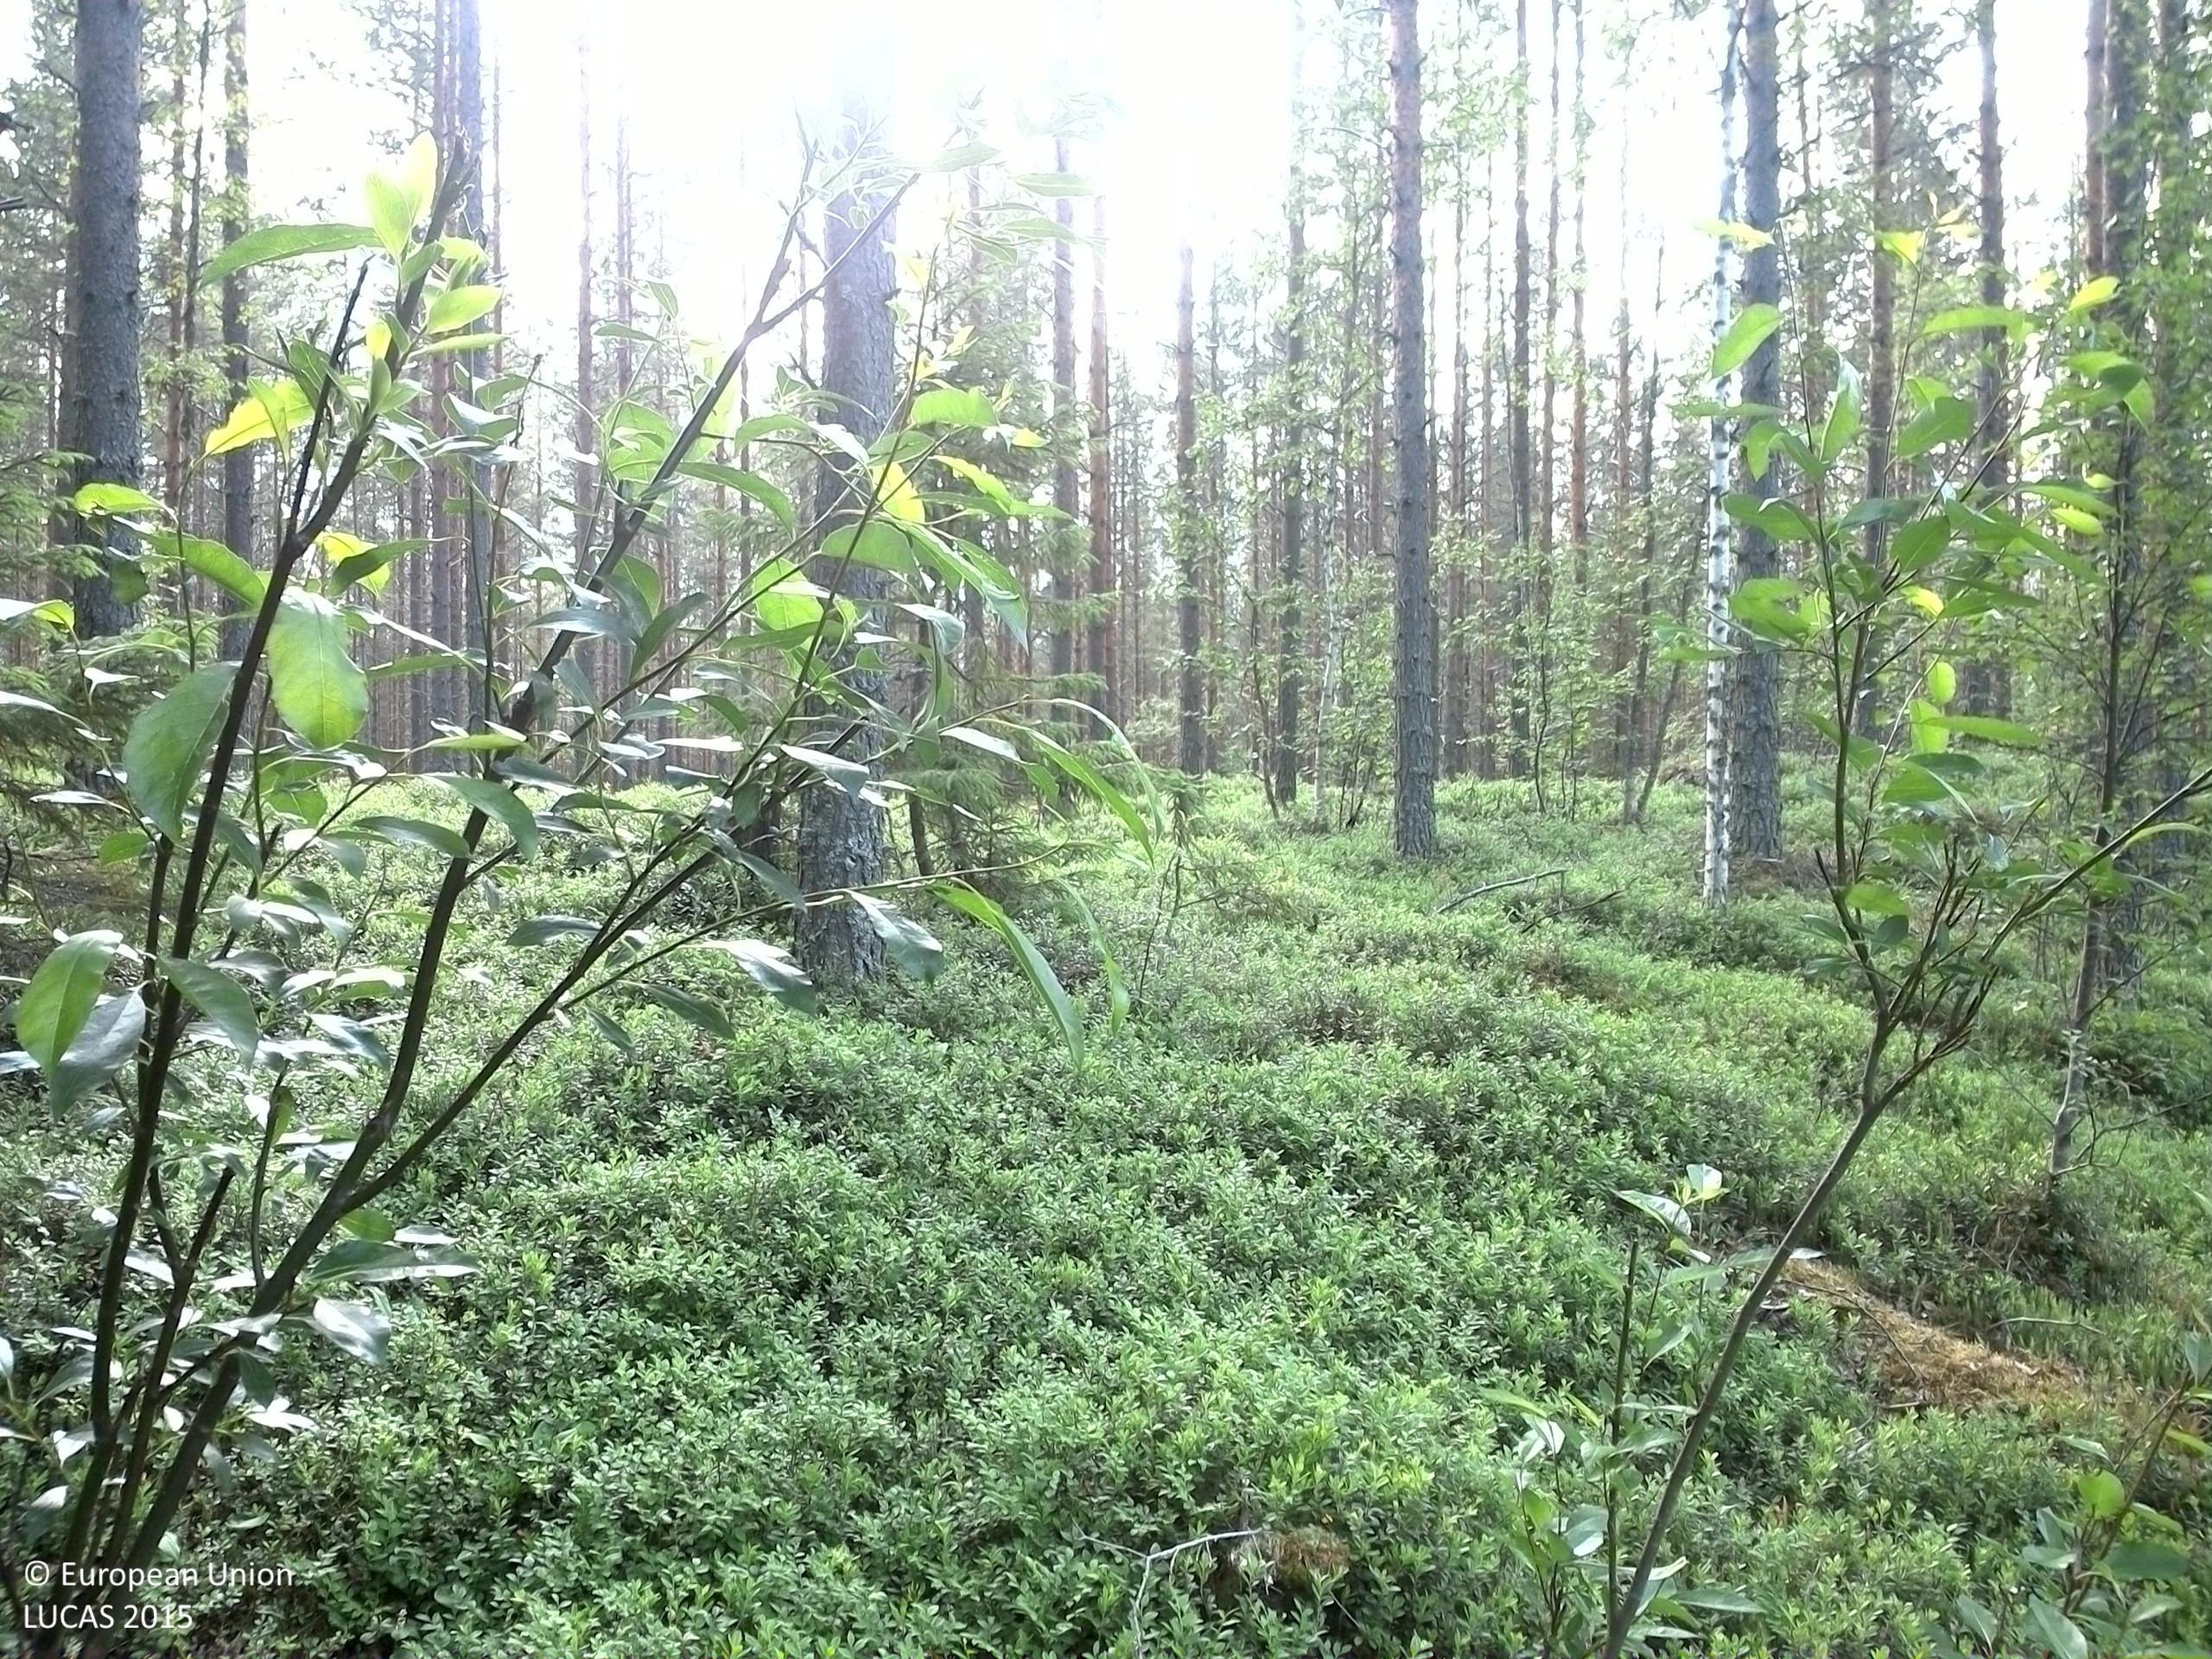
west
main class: Woodland
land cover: Spruce dominated mixed woodland
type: boreal forest
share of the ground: 50 - 75 %
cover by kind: coniferous forest trees 50 %, broadleaved forest trees 20 %, shrubs 15 %, herbaceous plants 15 %
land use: Forestry
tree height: > 5 m
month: July
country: SE
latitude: 63.5599
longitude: 17.2806
